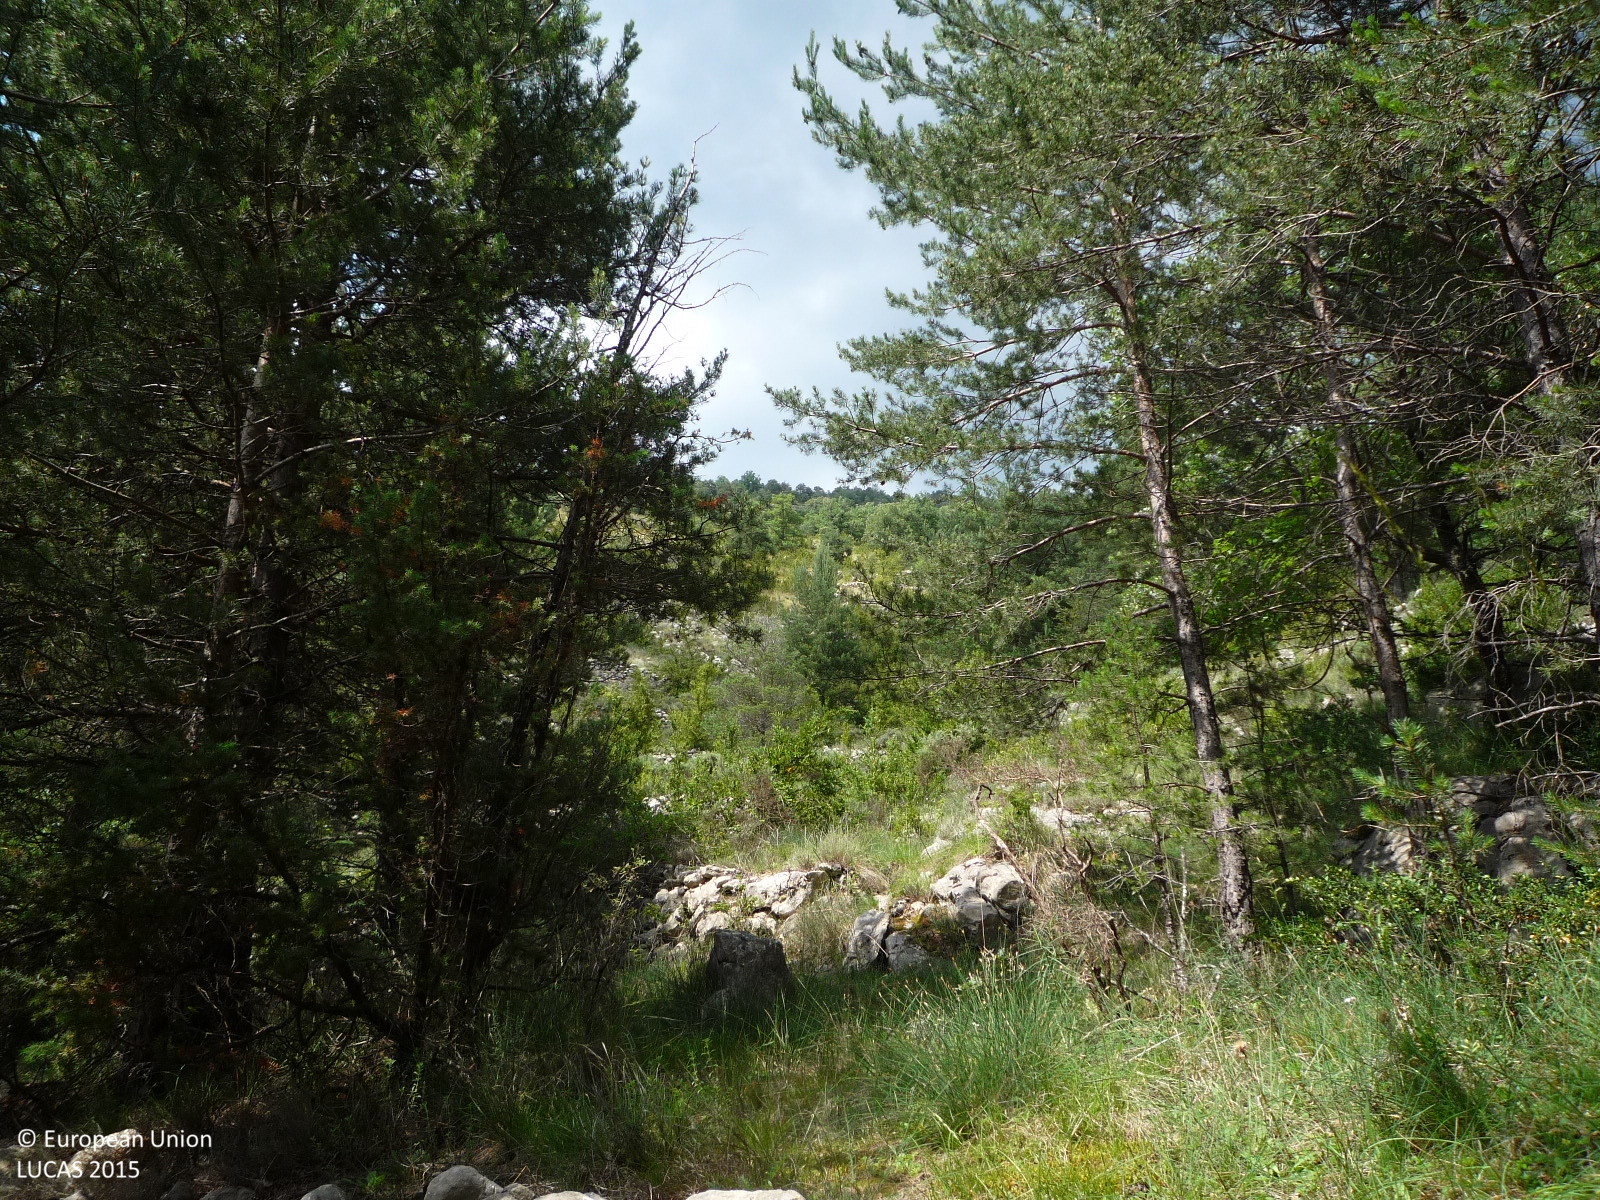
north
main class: Woodland
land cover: Pine dominated coniferous woodland
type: alpine coniferous forest
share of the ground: > 75 %
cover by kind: coniferous forest trees 80 %, herbaceous plants 20 %
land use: Semi-natural and natural areas not in use
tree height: > 5 m
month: June
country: ES
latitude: 42.2210
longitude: 1.9075
